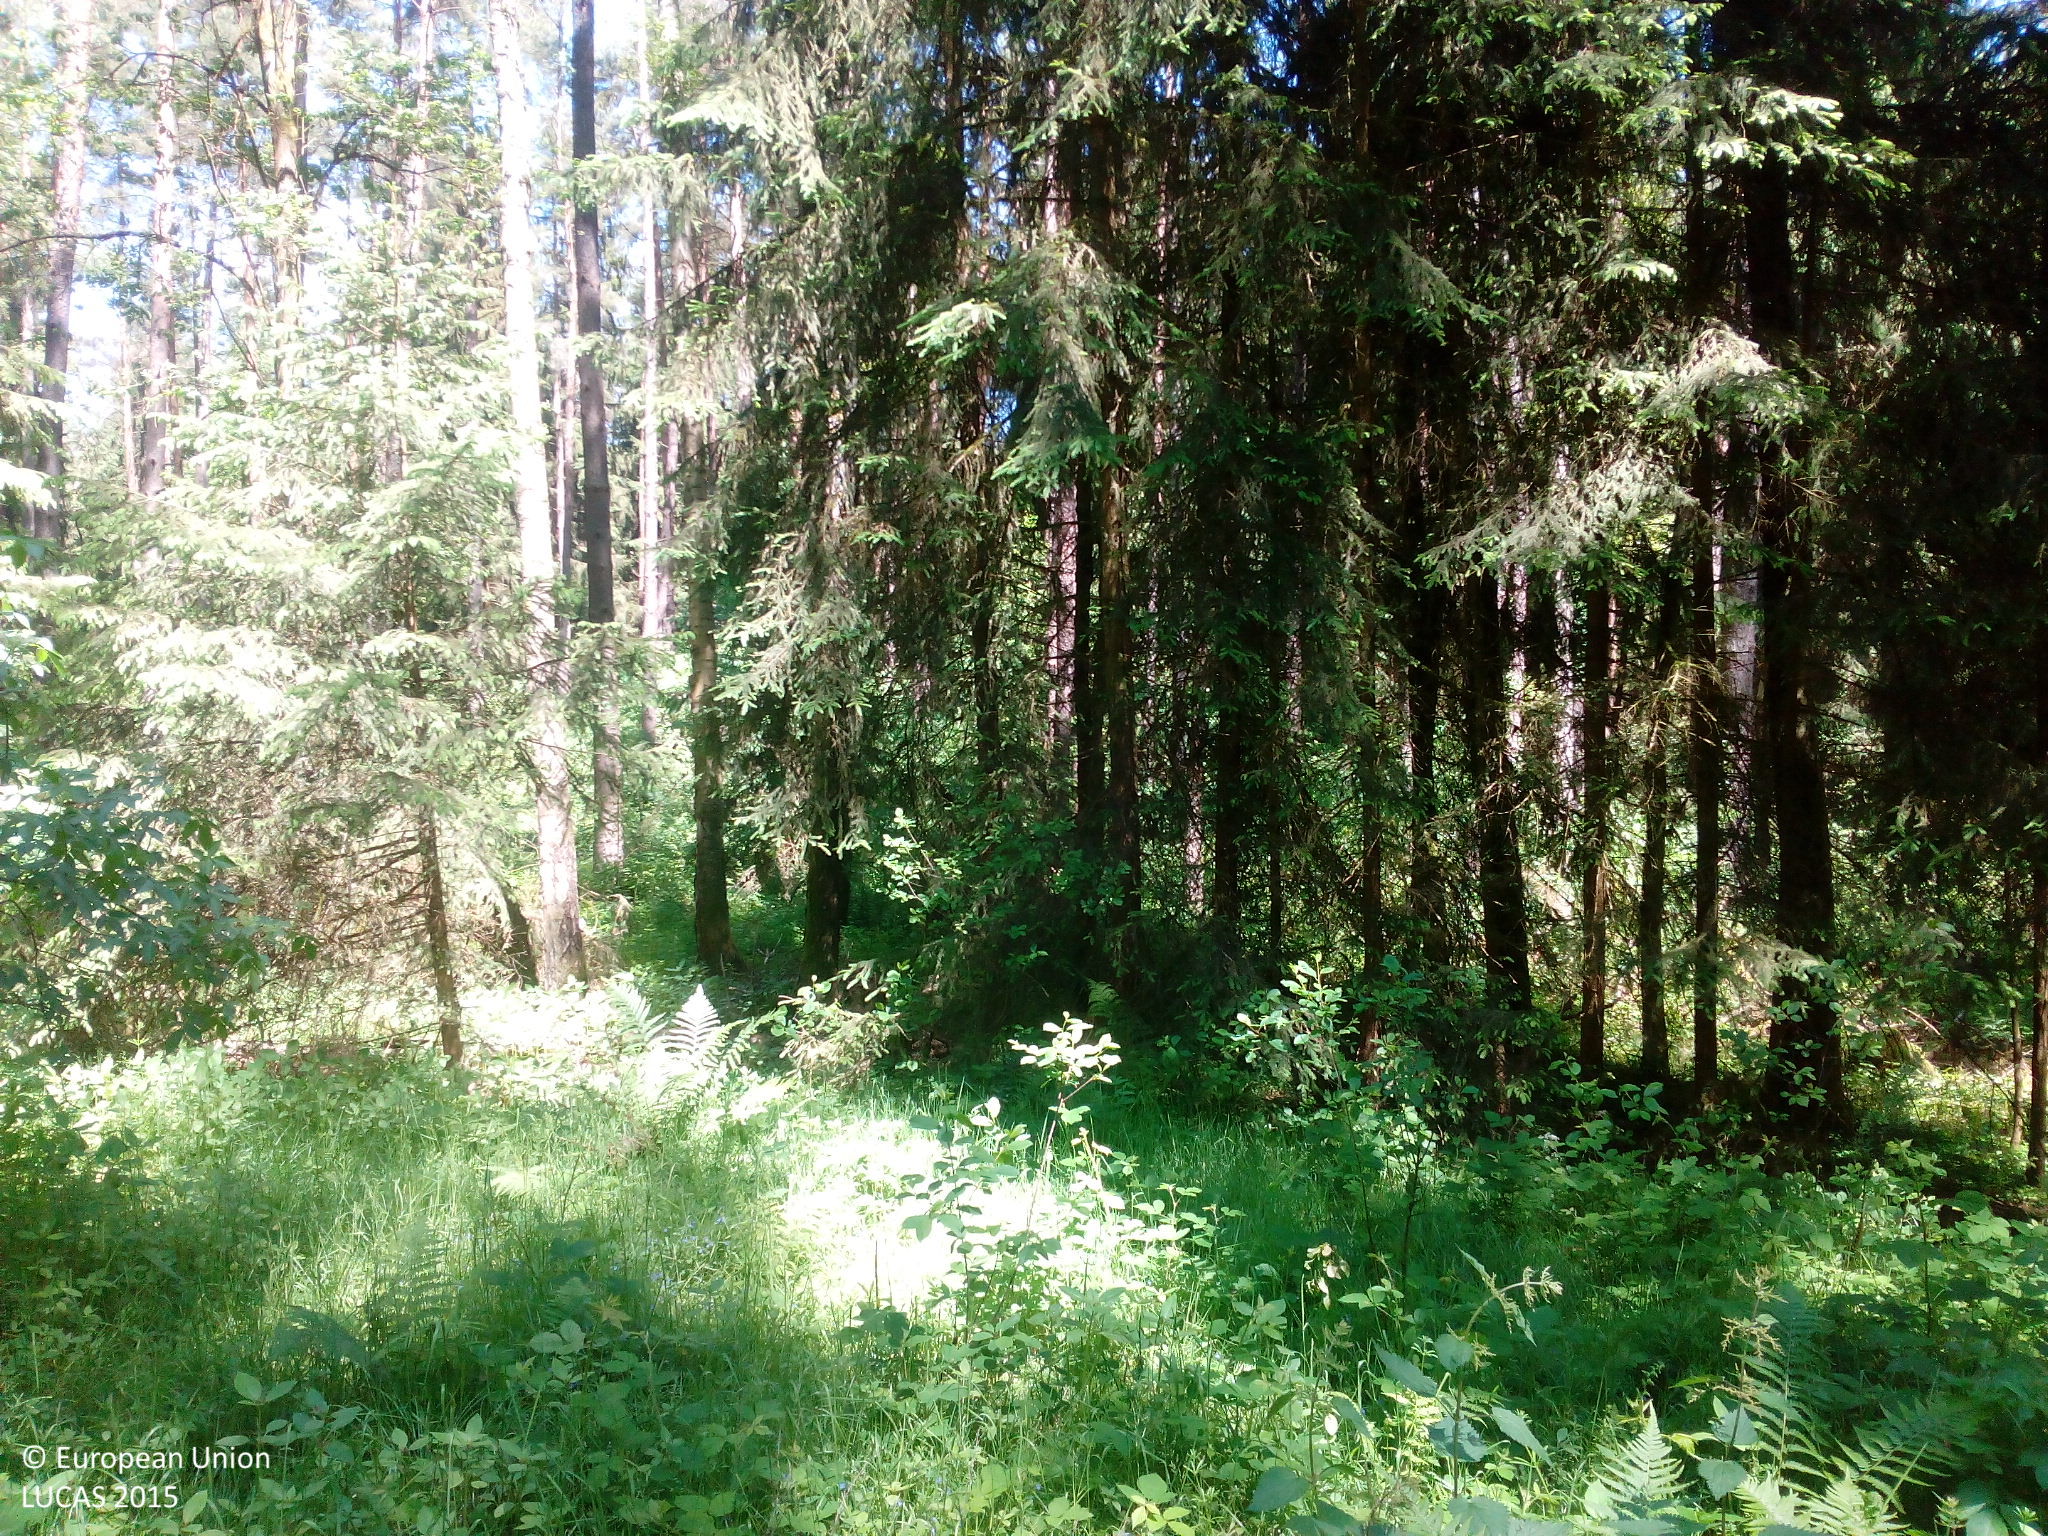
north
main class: Woodland
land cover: Spruce dominated mixed woodland
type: hemiboreal forest and nemoral coniferous forest and mixed broadleaved-coniferous forest
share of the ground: > 75 %
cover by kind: coniferous forest trees 65 %, broadleaved forest trees 25 %, herbaceous plants 10 %
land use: Forestry
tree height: > 5 m
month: June
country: DE
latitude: 49.4076
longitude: 12.1908
